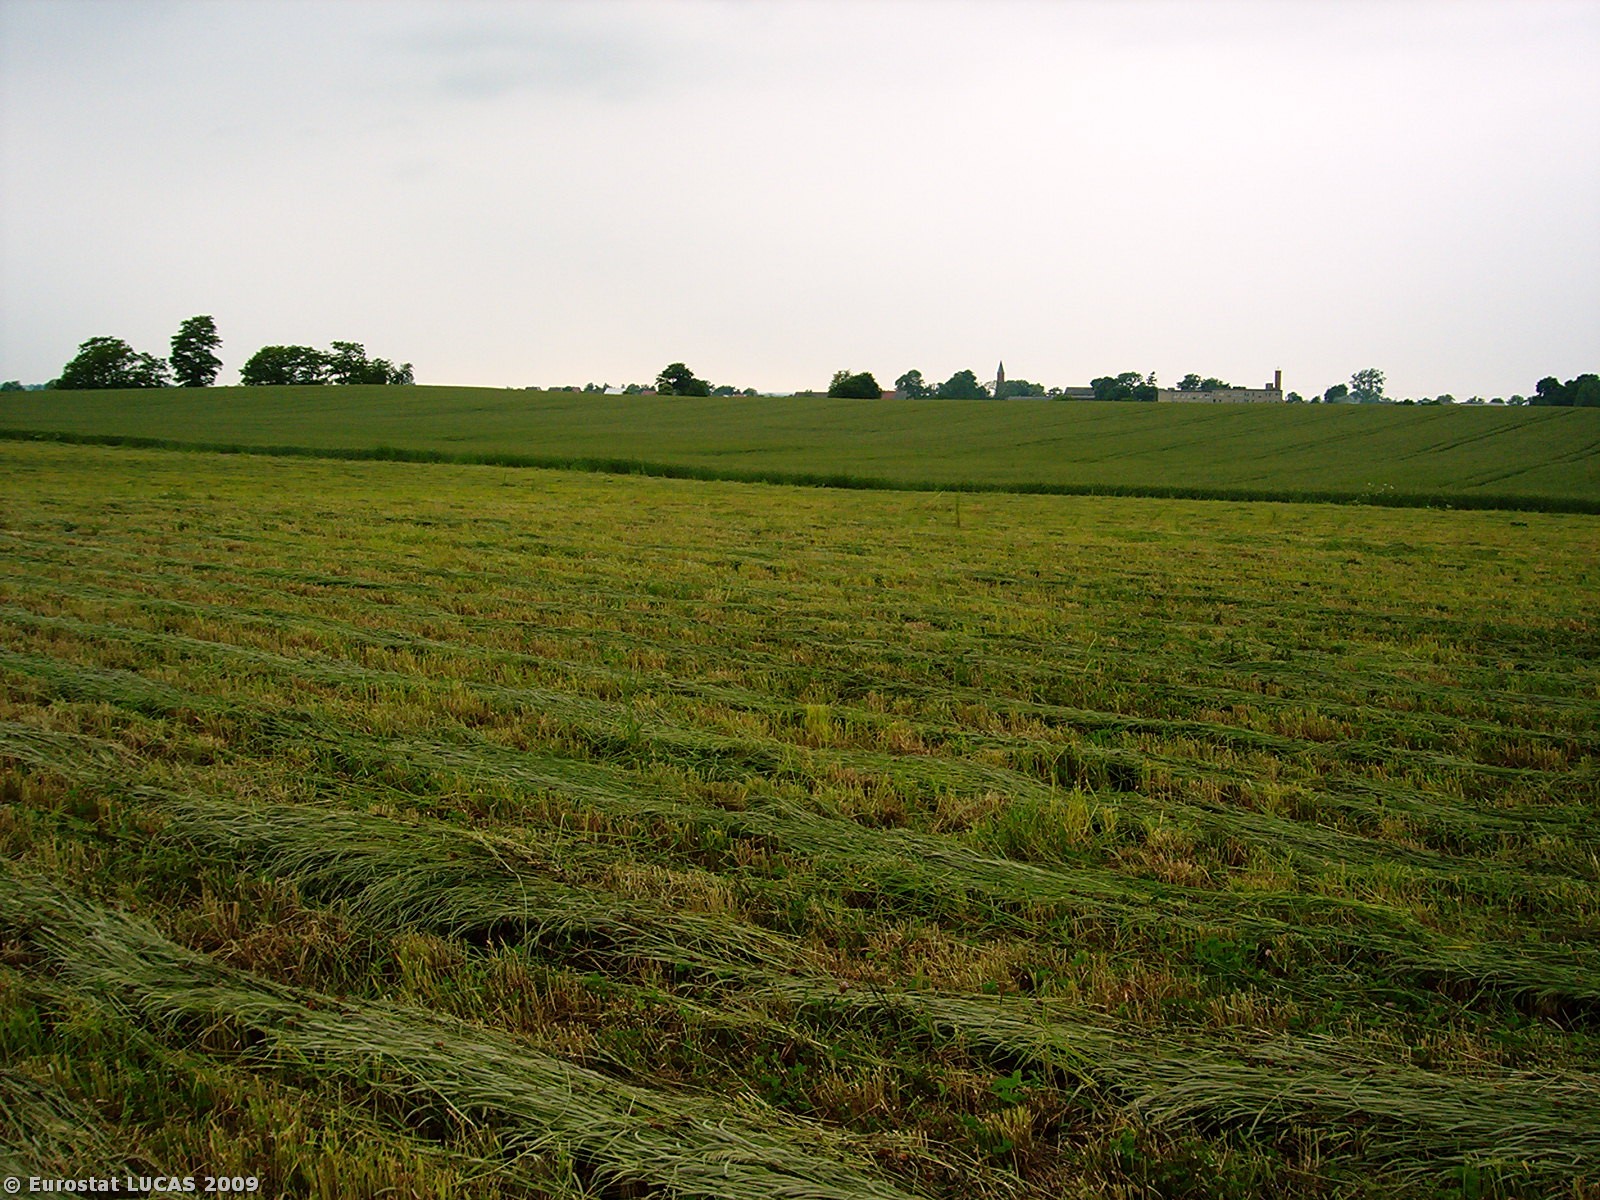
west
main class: Cropland
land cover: Clovers
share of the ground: > 75 %
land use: Agriculture (excluding fallow land and kitchen gardens)
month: June
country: PL
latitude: 53.0631
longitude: 15.4502
